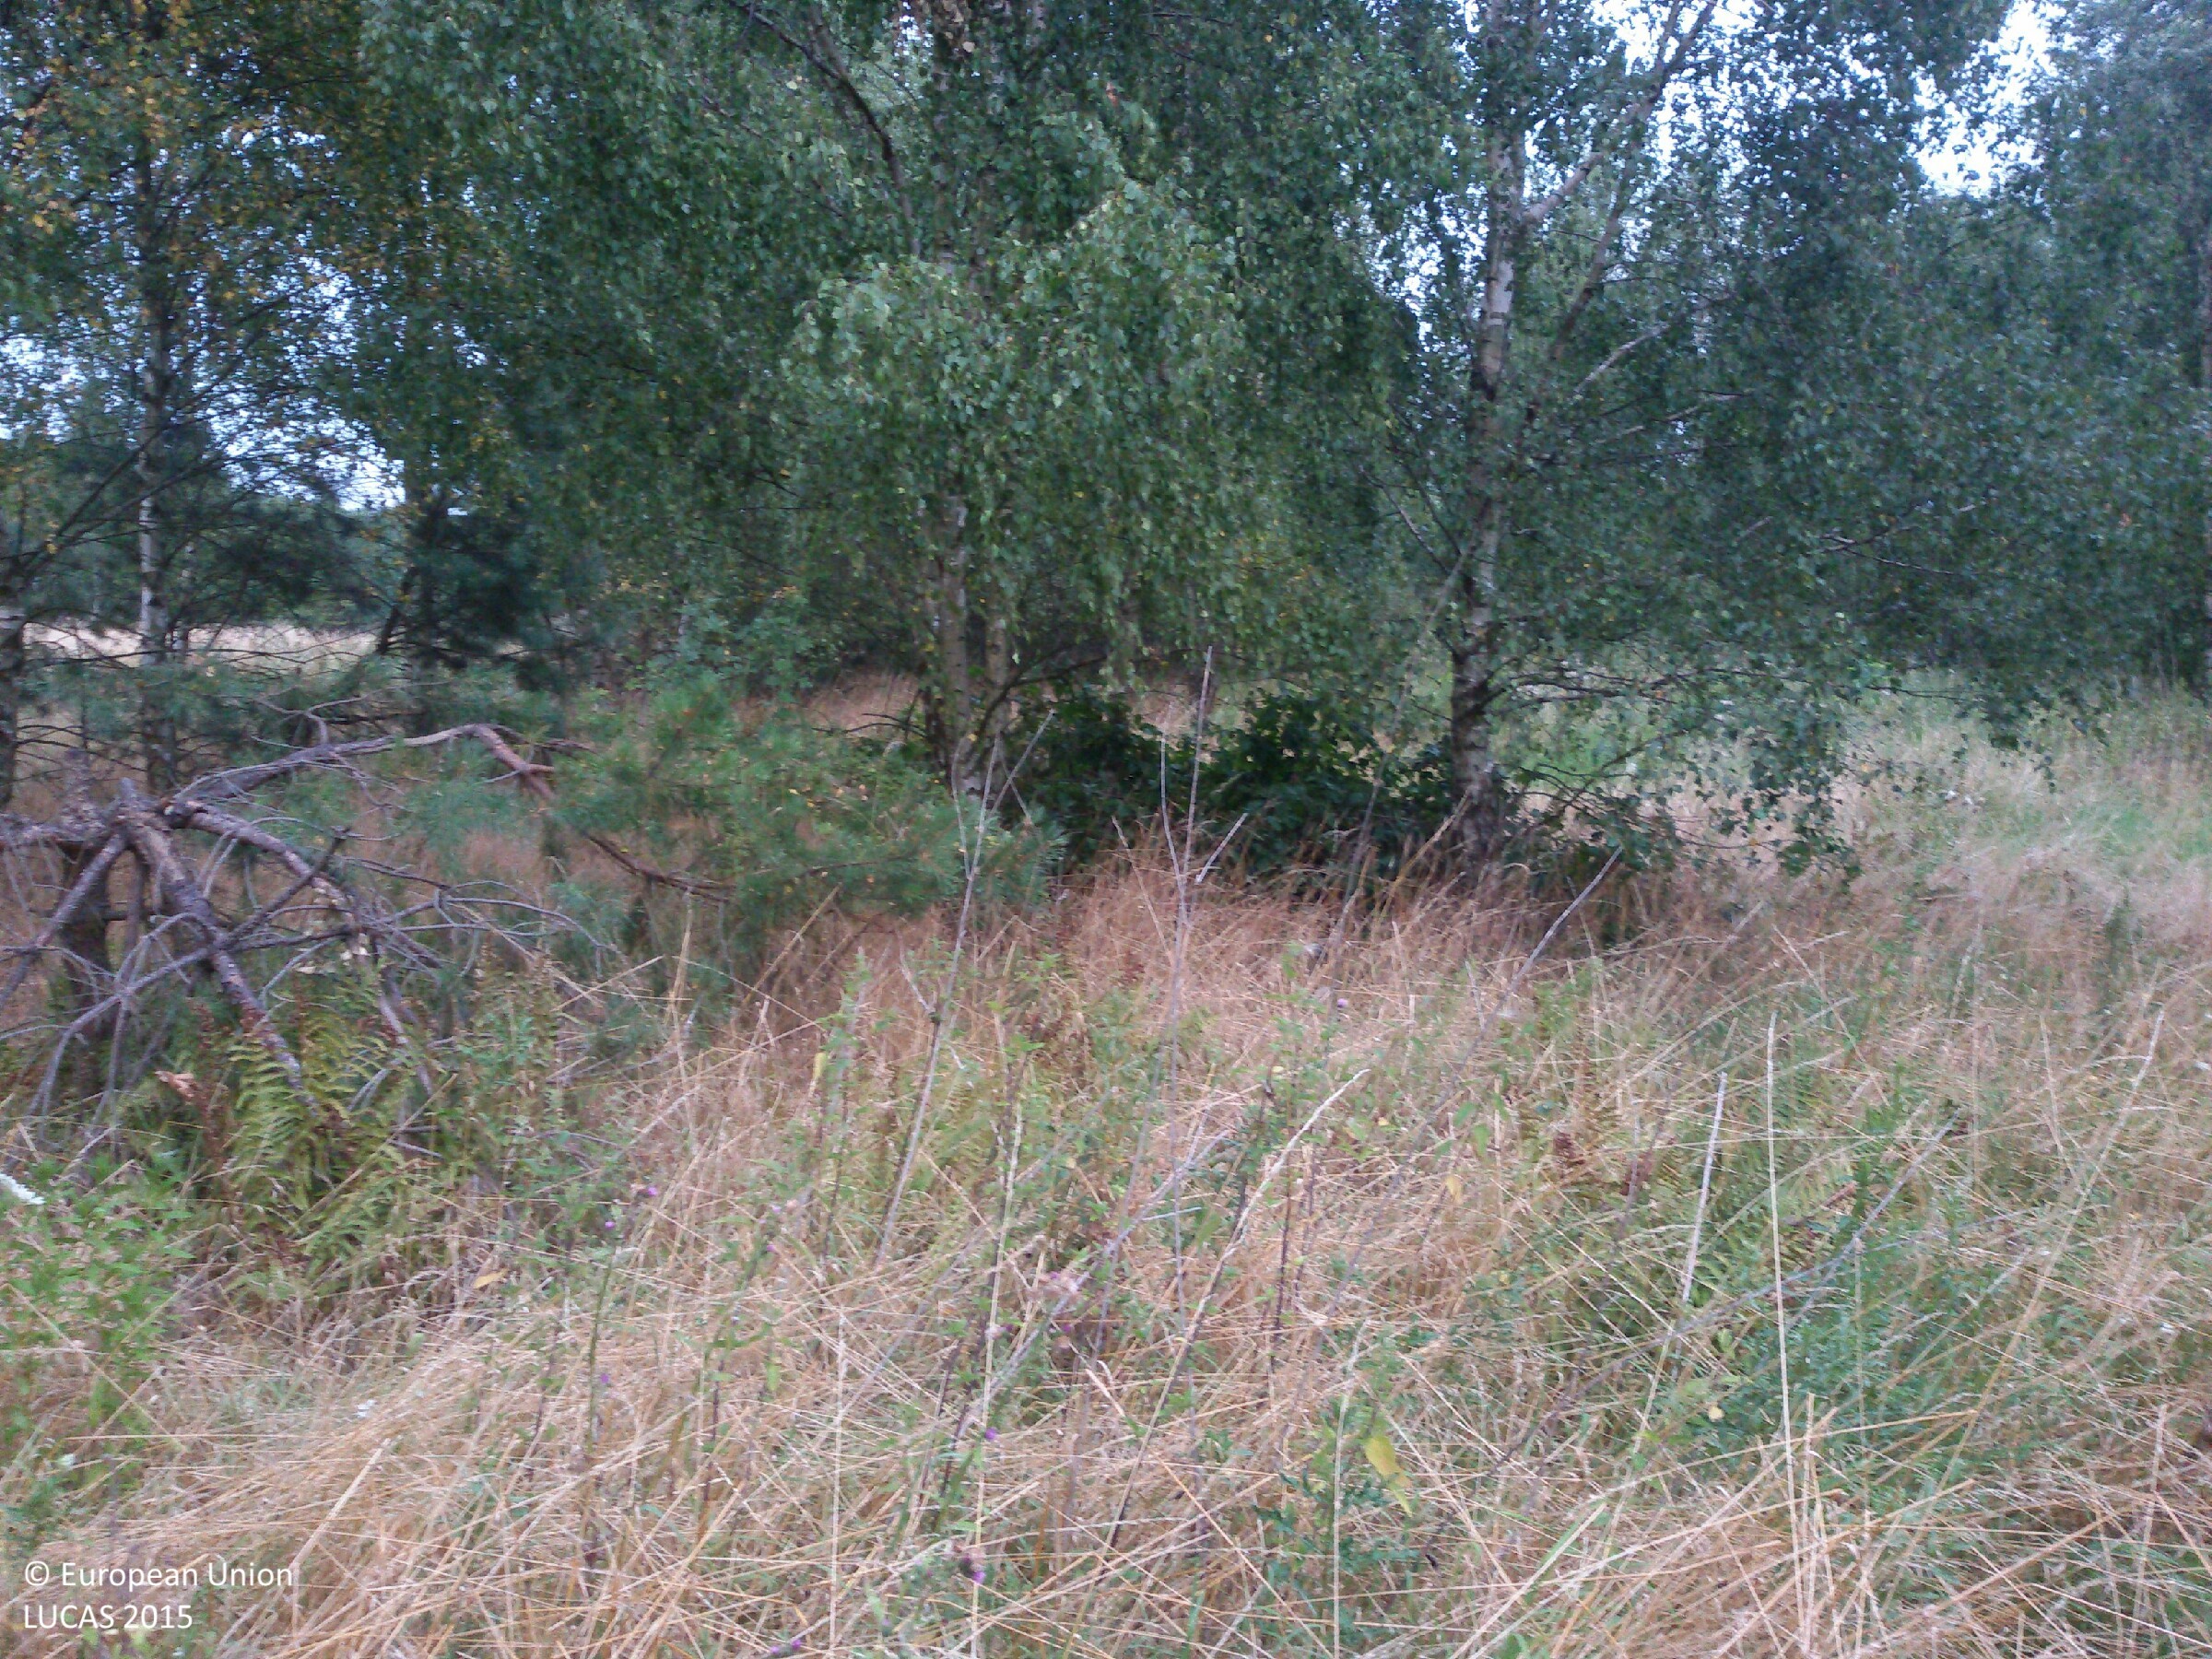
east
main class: Woodland
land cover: Broadleaved woodland
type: mesophytic deciduous forest
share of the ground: 25 - 50 %
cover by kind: herbaceous plants 55 %, broadleaved forest trees 30 %, shrubs 10 %, coniferous forest trees 5 %
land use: Semi-natural and natural areas not in use
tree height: > 5 m
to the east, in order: Broadleaved woodland; Grass margins; Tracks; Grass margins; Pine dominated mixed woodland; Spontaneously vegetated surfaces; Single bushes/trees; Spontaneously vegetated surfaces; Single bushes/trees; Spontaneously vegetated surfaces; Pine dominated coniferous woodland; Tracks
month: August
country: PL
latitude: 52.9960
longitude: 14.4561
